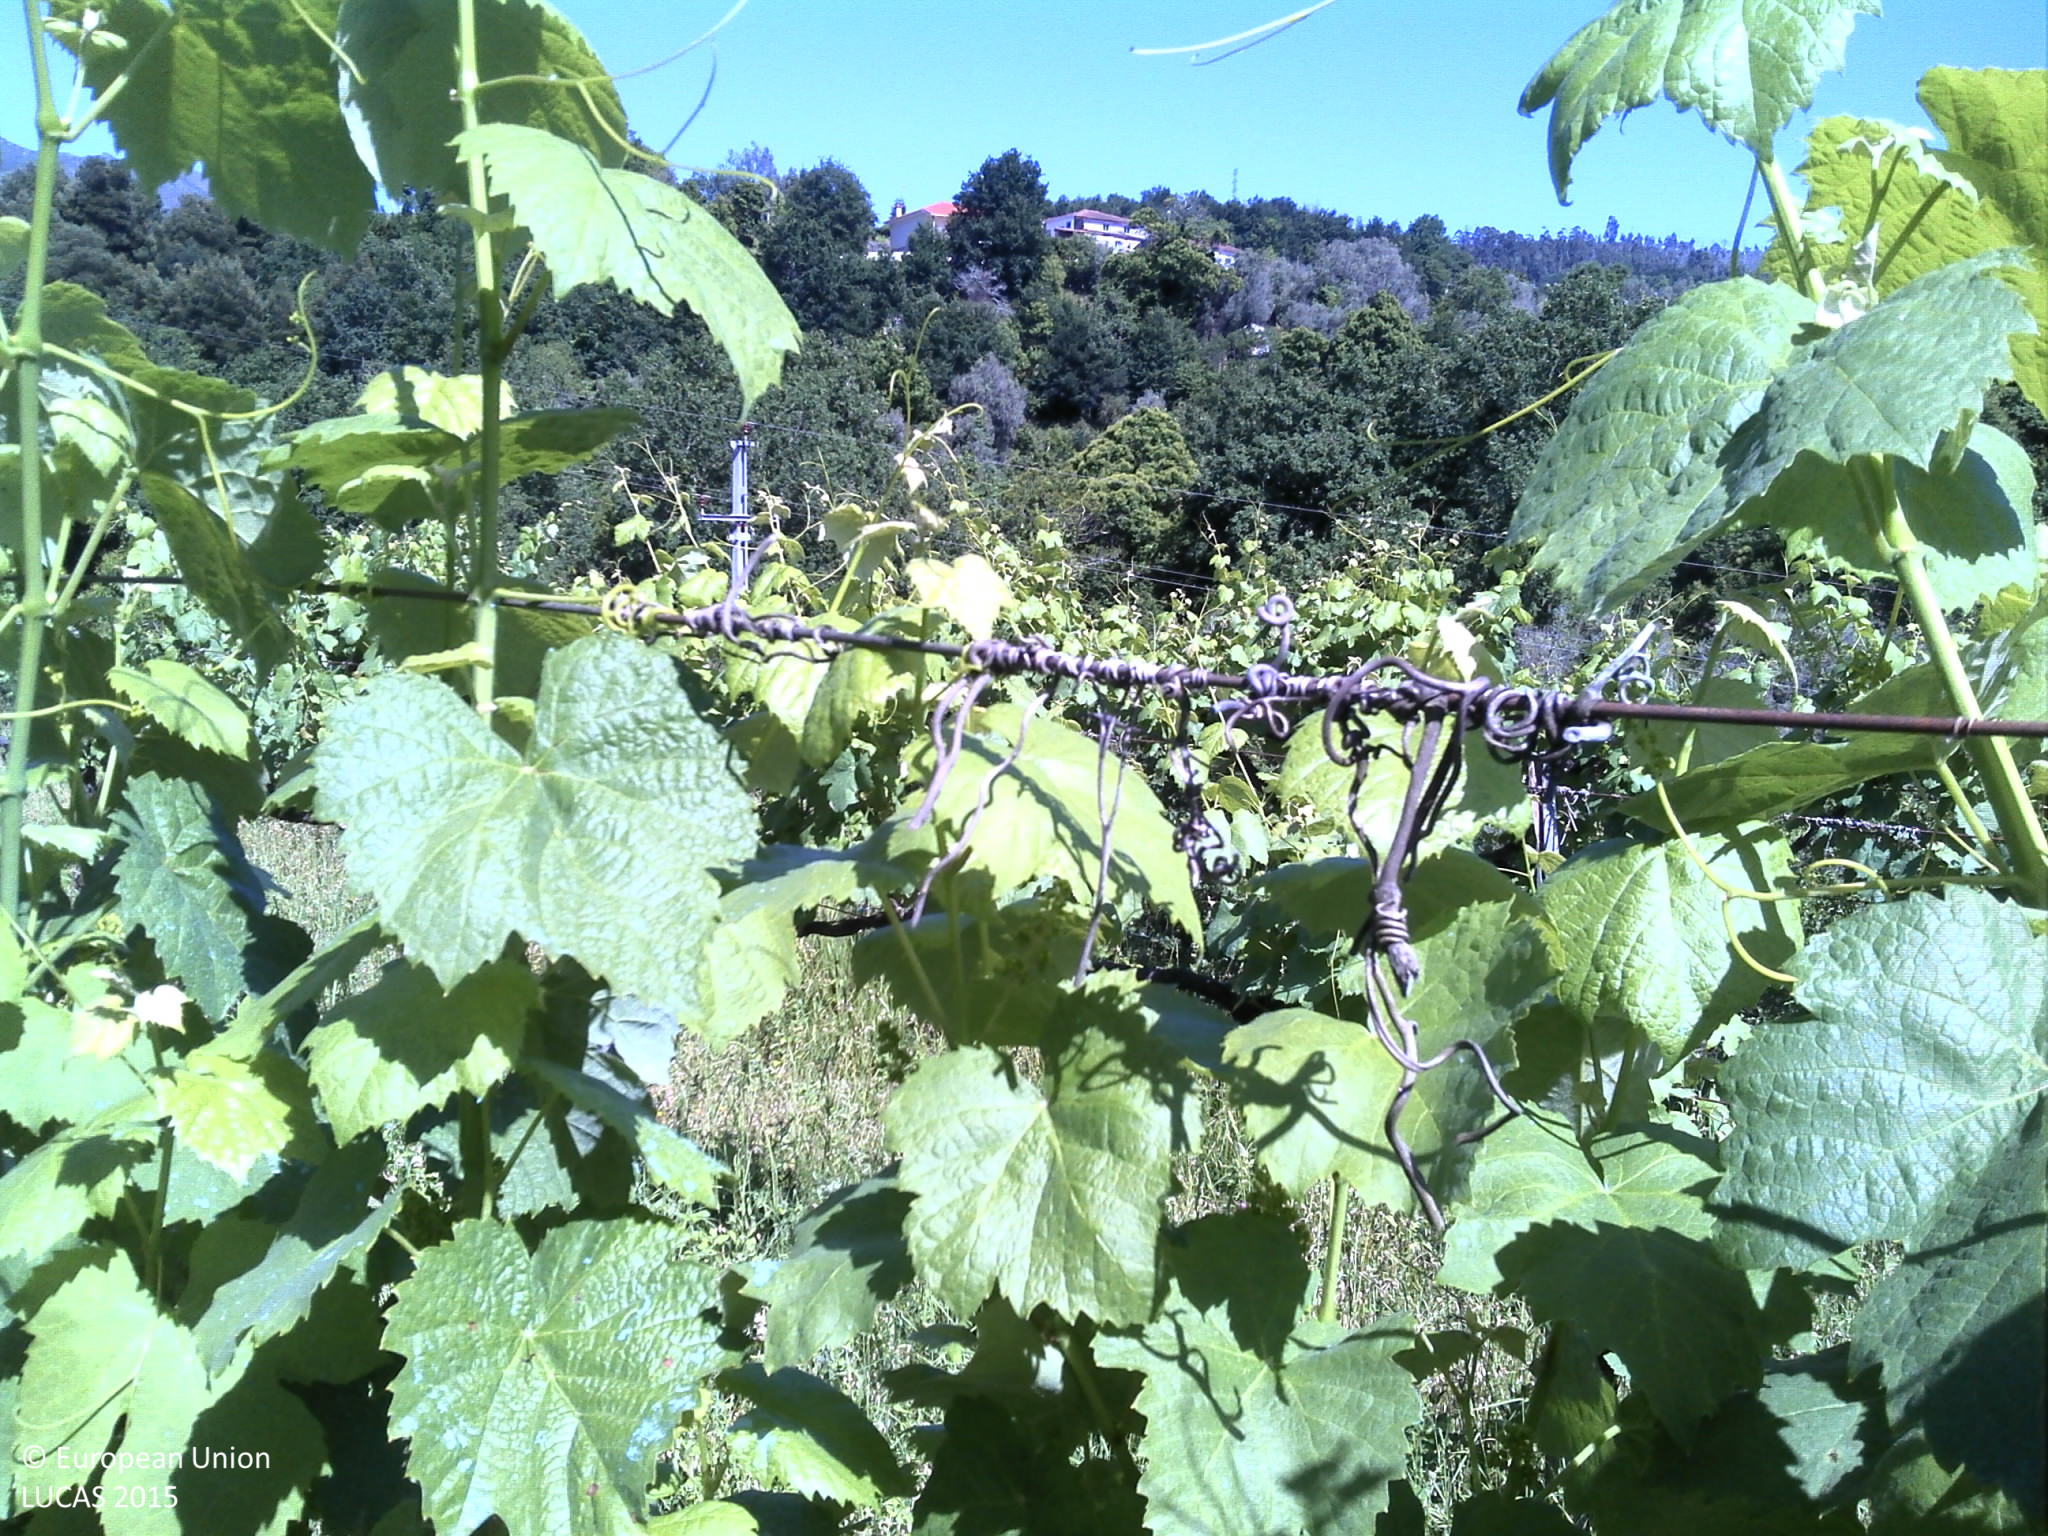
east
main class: Cropland
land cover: Vineyards
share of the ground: 10 - 25 %
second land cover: Grassland without tree/shrub cover
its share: 50 - 75 %
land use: Agriculture (excluding fallow land and kitchen gardens)
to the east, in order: Vineyards; Grassland without tree/shrub cover; Vineyards; Fences; Vineyards; Other fruit trees and berries; Spontaneously vegetated surfaces; Broadleaved woodland; Rivers and streams; Broadleaved woodland
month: June
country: PT
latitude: 41.8419
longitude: -8.3783
